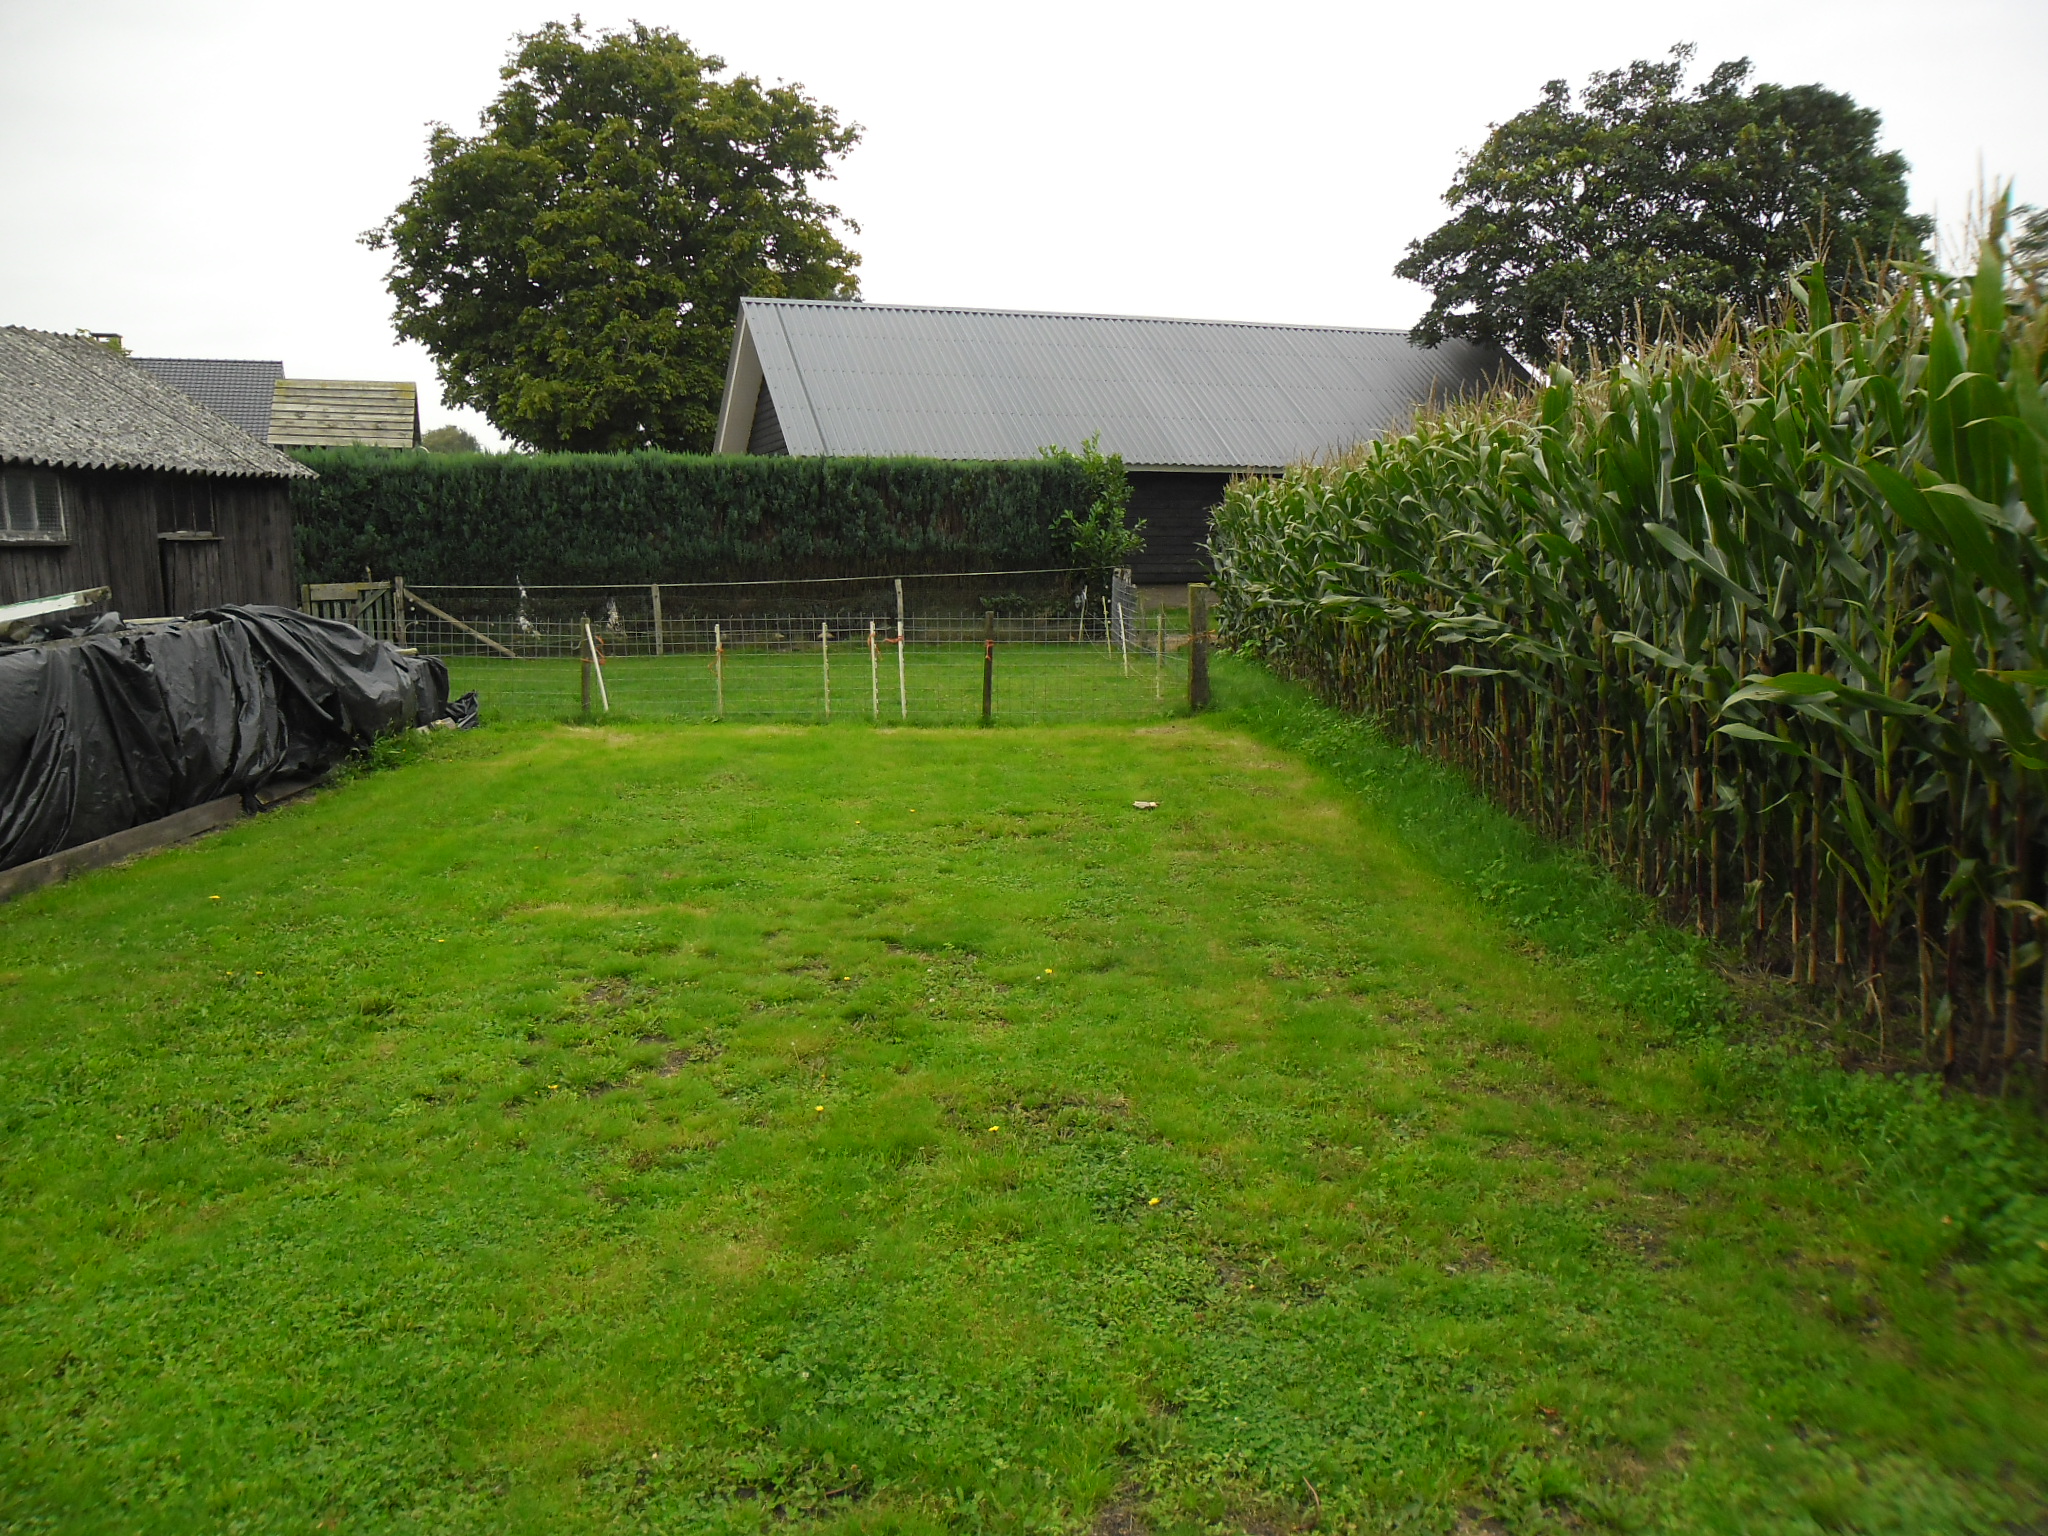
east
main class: Grassland
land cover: Grassland without tree/shrub cover
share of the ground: > 75 %
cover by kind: herbaceous plants 100 %
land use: Residential
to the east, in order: Grassland without tree/shrub cover; Maize; Grass margins; Single bushes/trees; Artificial constructions in urban areas; Grassland without tree/shrub cover; Fences; Grassland without tree/shrub cover; Fences; Lines of trees; Broadleaved woodland; Fences; Grassland without tree/shrub cover; Artificial constructions in urban areas
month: September
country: NL
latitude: 52.1193
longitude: 5.6902
